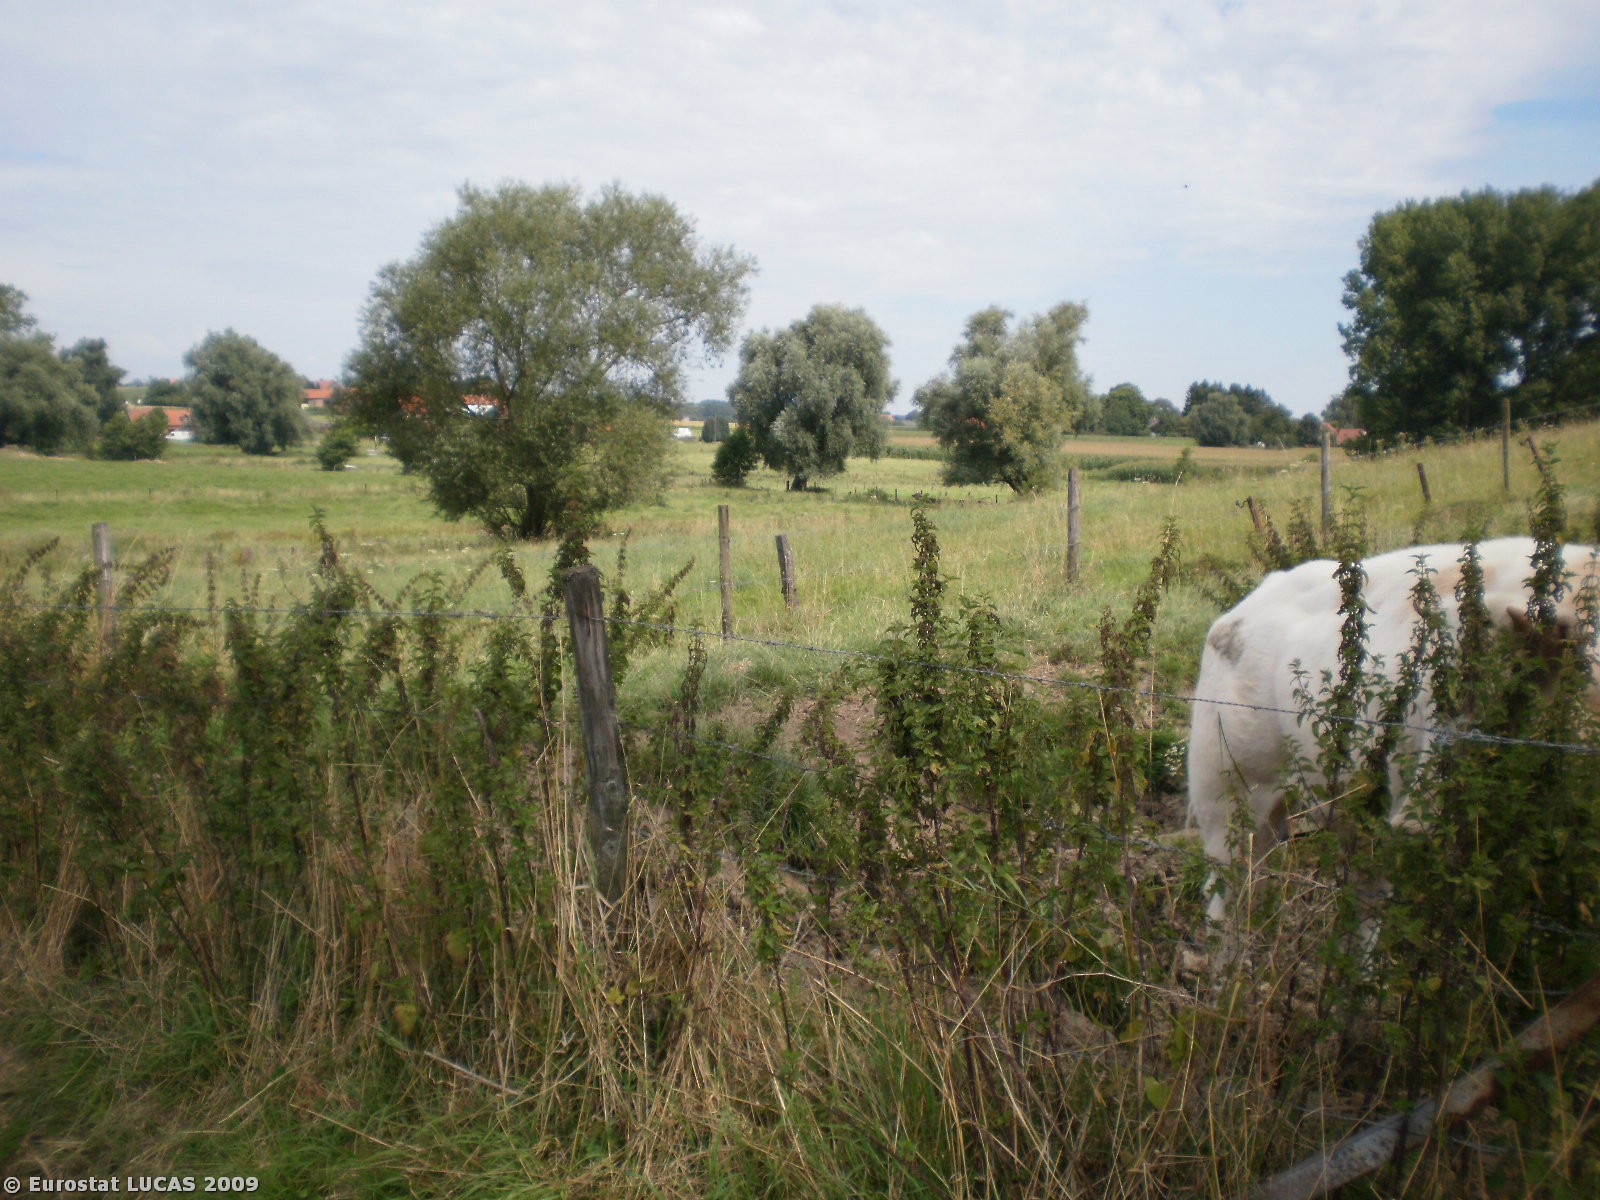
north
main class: Grassland
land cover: Grassland without tree/shrub cover
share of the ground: > 75 %
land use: Agriculture (excluding fallow land and kitchen gardens)
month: August
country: BE
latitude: 50.7354
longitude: 3.7731
